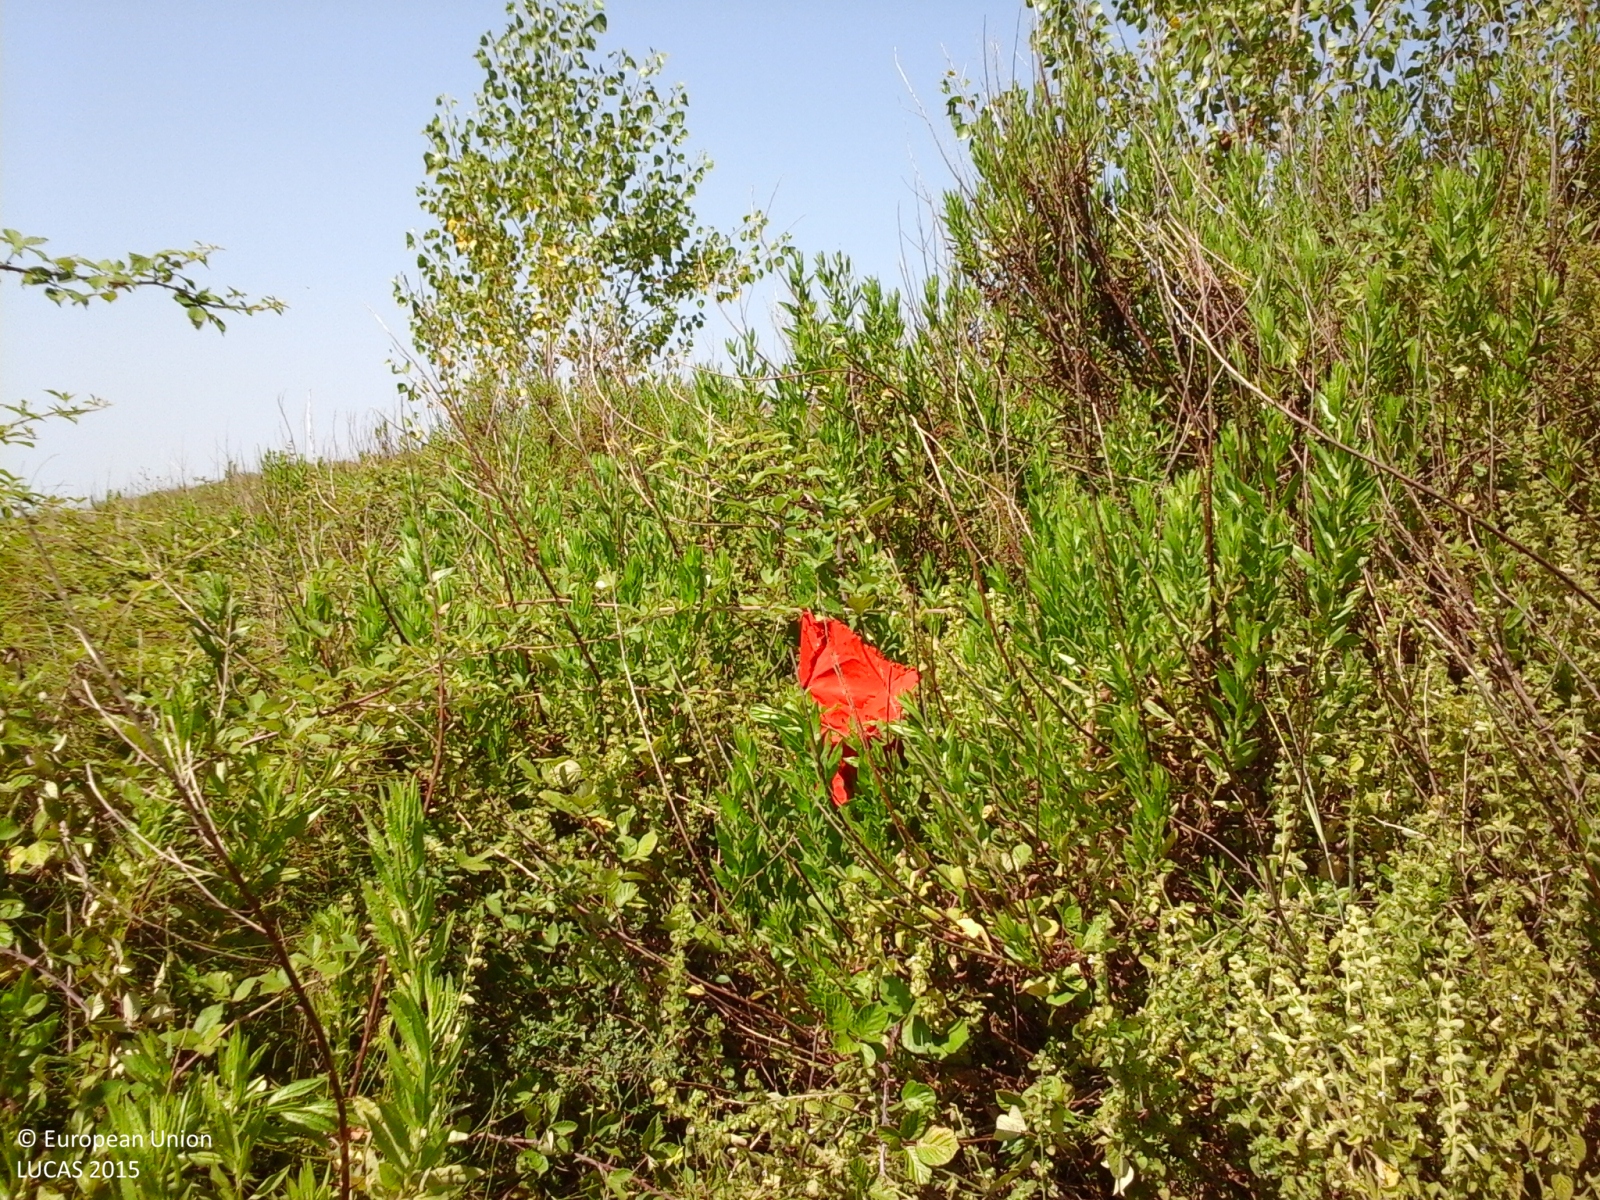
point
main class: Grassland
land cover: Spontaneously vegetated surfaces
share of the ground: > 75 %
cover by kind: herbaceous plants 85 %, shrubs 5 %, consolidated bare surface 5 %, unconsolidated bare surface 5 %
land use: Abandoned areas
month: July
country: IT
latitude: 42.9735
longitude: 11.0634
